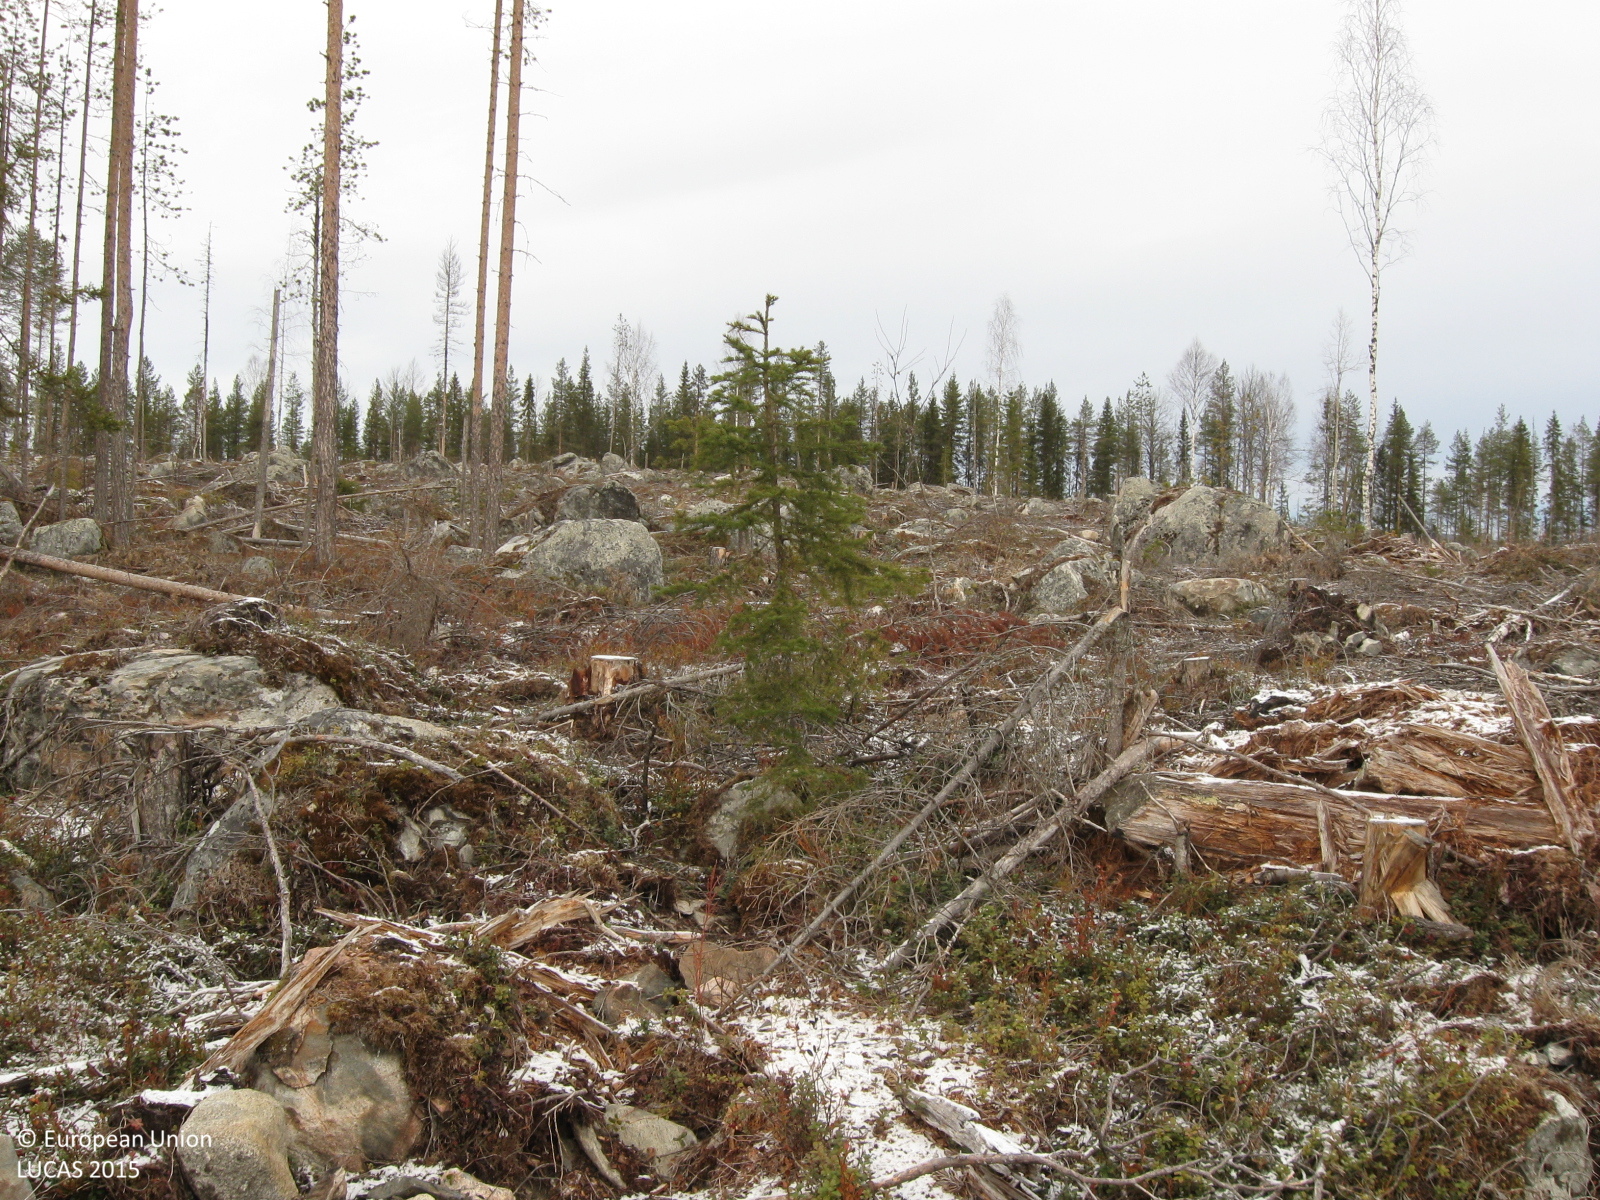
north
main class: Shrubland
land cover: Shrubland with sparse tree cover
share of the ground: 25 - 50 %
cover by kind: shrubs 45 %, consolidated bare surface 15 %, herbaceous plants 10 %, lichens and mosses 10 %, coniferous forest trees 5 %, unconsolidated bare surface 5 %
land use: Forestry
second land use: Amenities, museums, leisure
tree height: < 5 m
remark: Clear cut
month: October
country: SE
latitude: 66.2125
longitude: 21.4973
